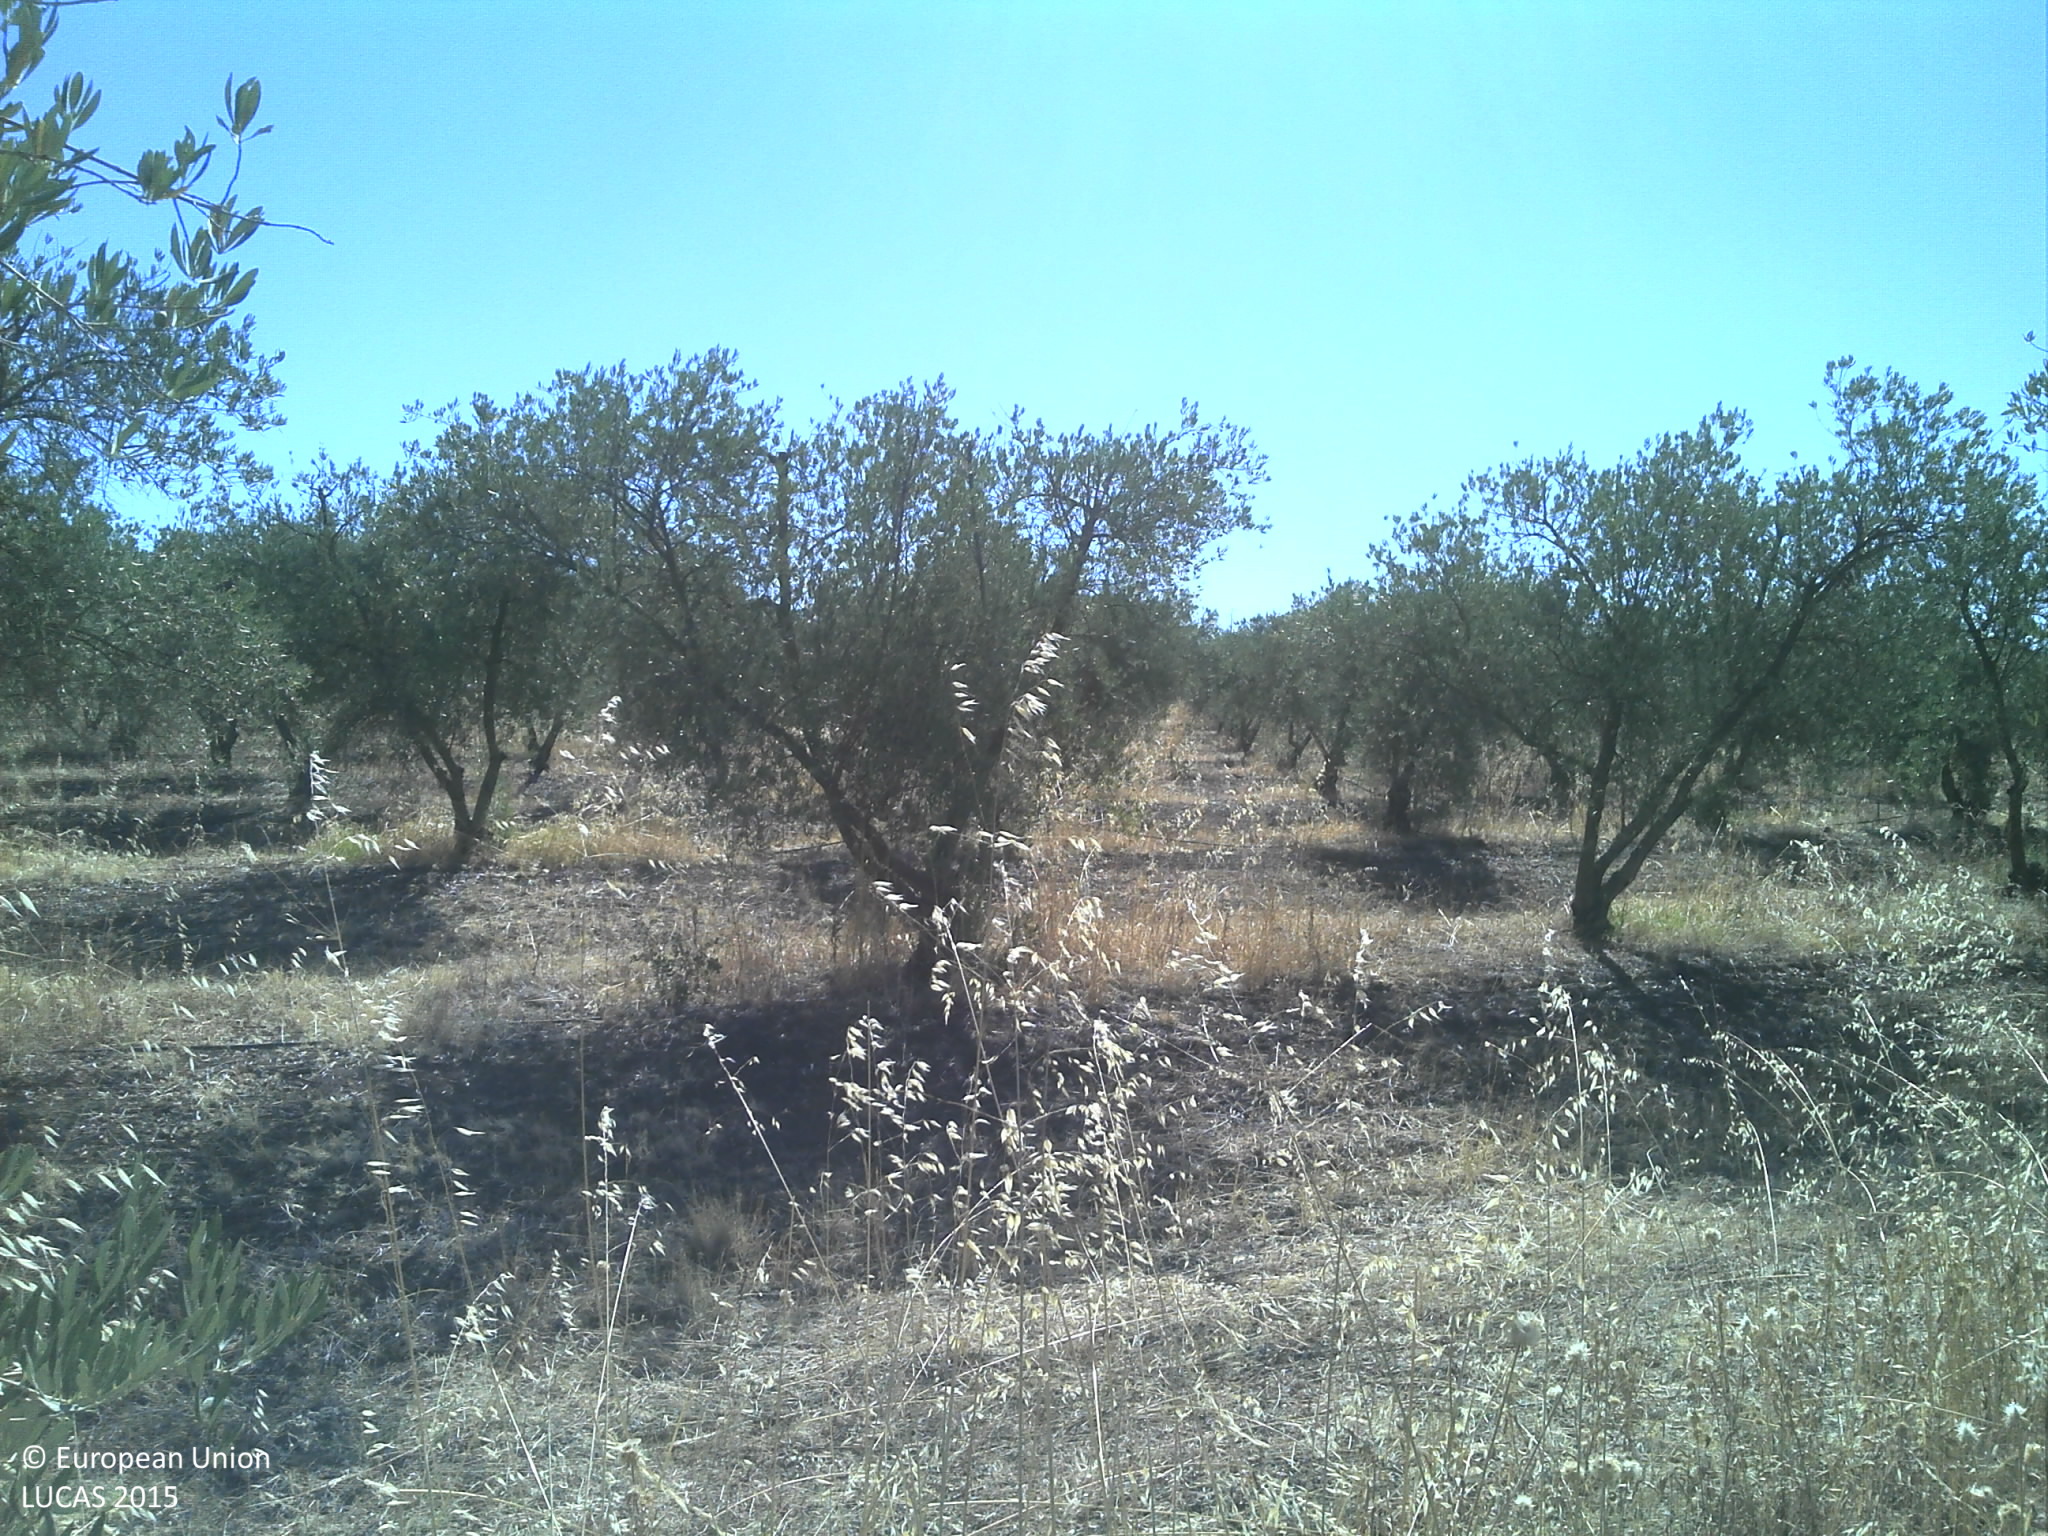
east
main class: Cropland
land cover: Olive groves
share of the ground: 50 - 75 %
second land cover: Grassland without tree/shrub cover
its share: 10 - 25 %
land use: Agriculture (excluding fallow land and kitchen gardens)
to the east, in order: Olive groves; Grassland without tree/shrub cover; Olive groves; Spontaneously vegetated surfaces; Olive groves
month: July
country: PT
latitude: 39.0318
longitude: -7.0912
